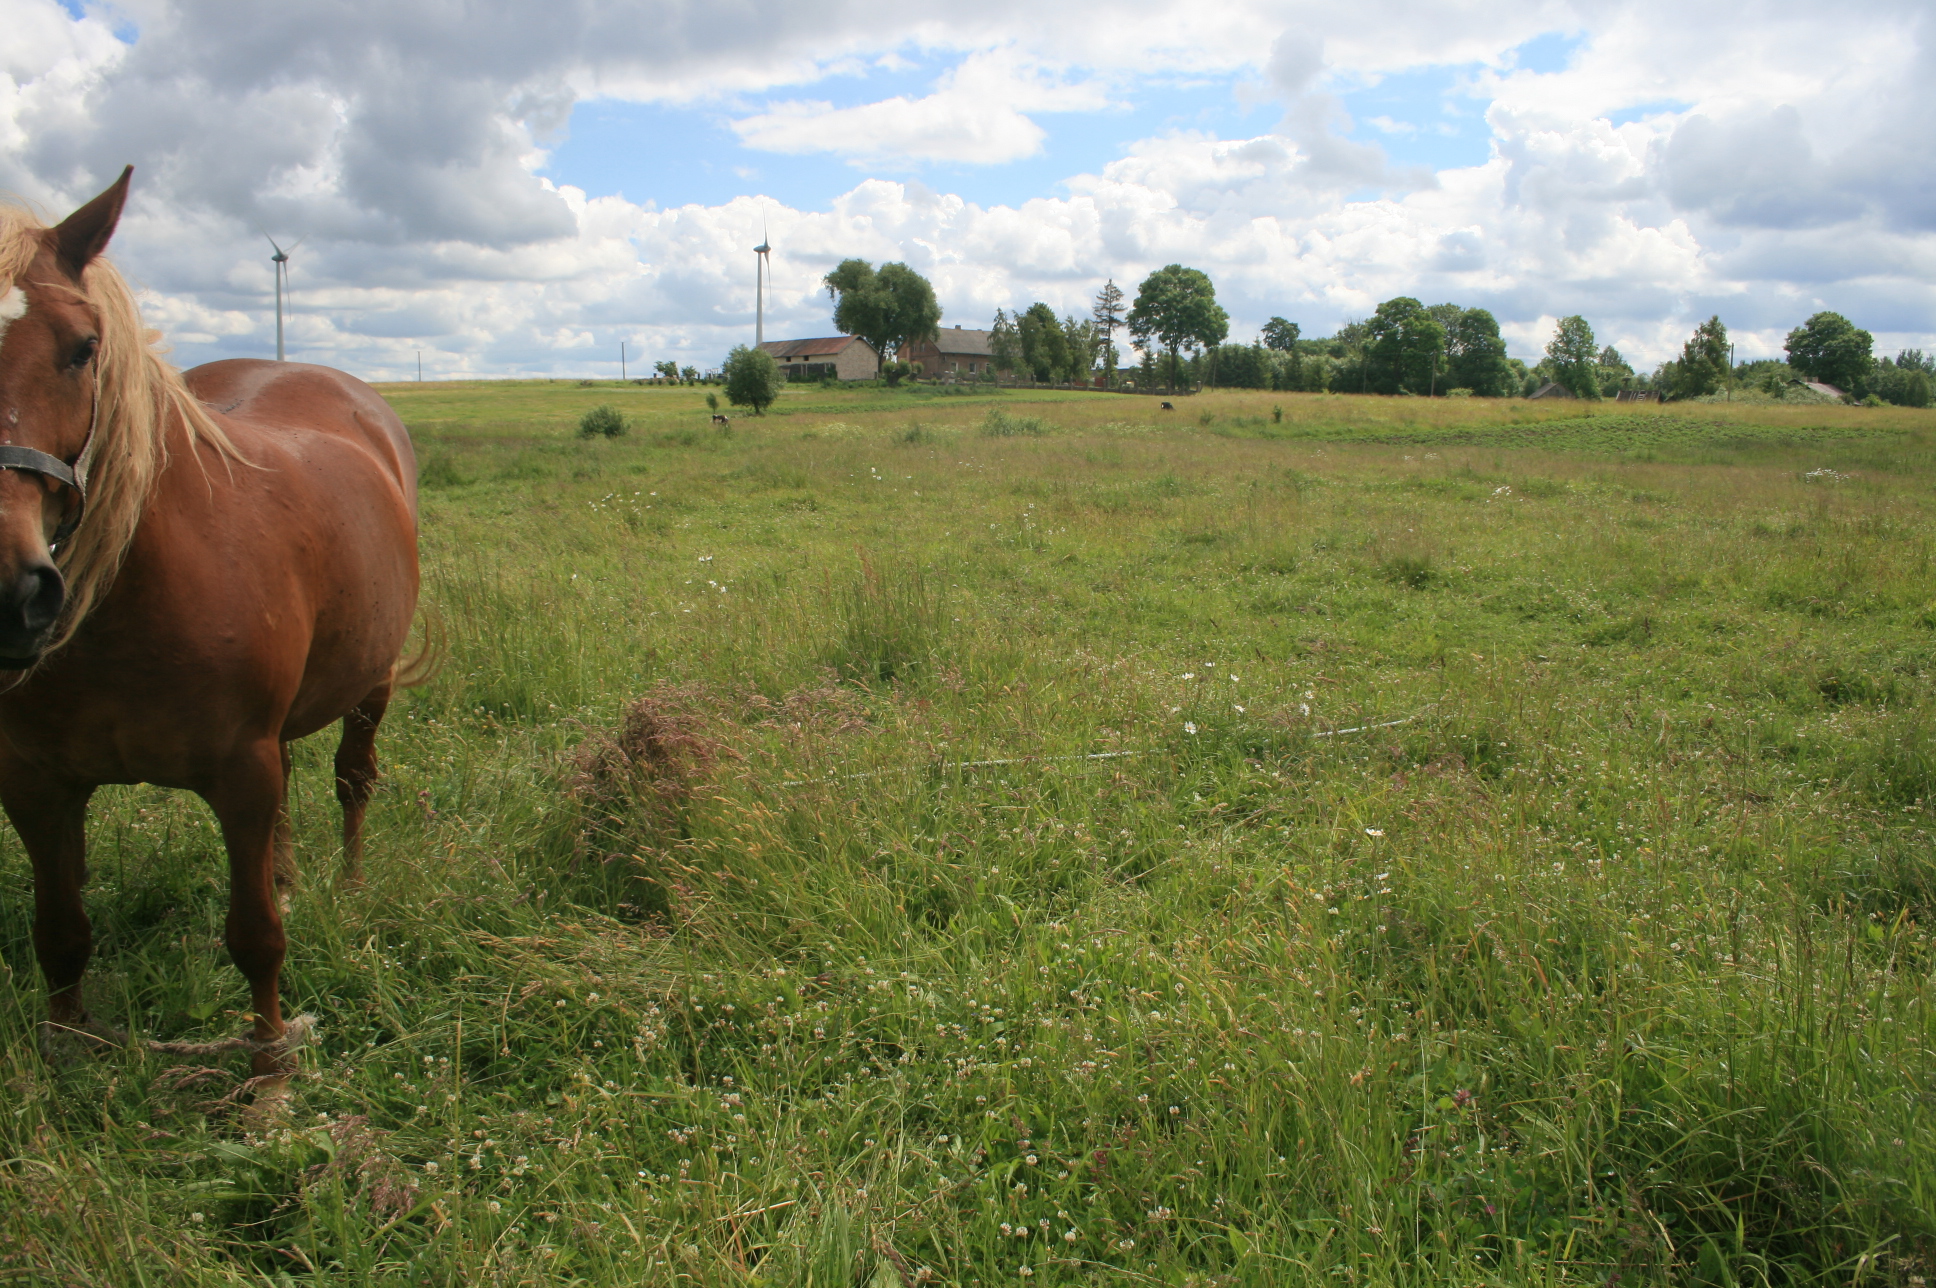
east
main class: Grassland
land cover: Grassland without tree/shrub cover
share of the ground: > 75 %
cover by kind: herbaceous plants 100 %
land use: Agriculture (excluding fallow land and kitchen gardens)
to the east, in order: Grassland without tree/shrub cover; Spontaneously vegetated surfaces; Grassland without tree/shrub cover; Grassland with sparse tree/shrub cover; Artificial constructions in urban areas; Grassland without tree/shrub cover
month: June
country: LT
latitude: 55.1966
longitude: 22.0733
